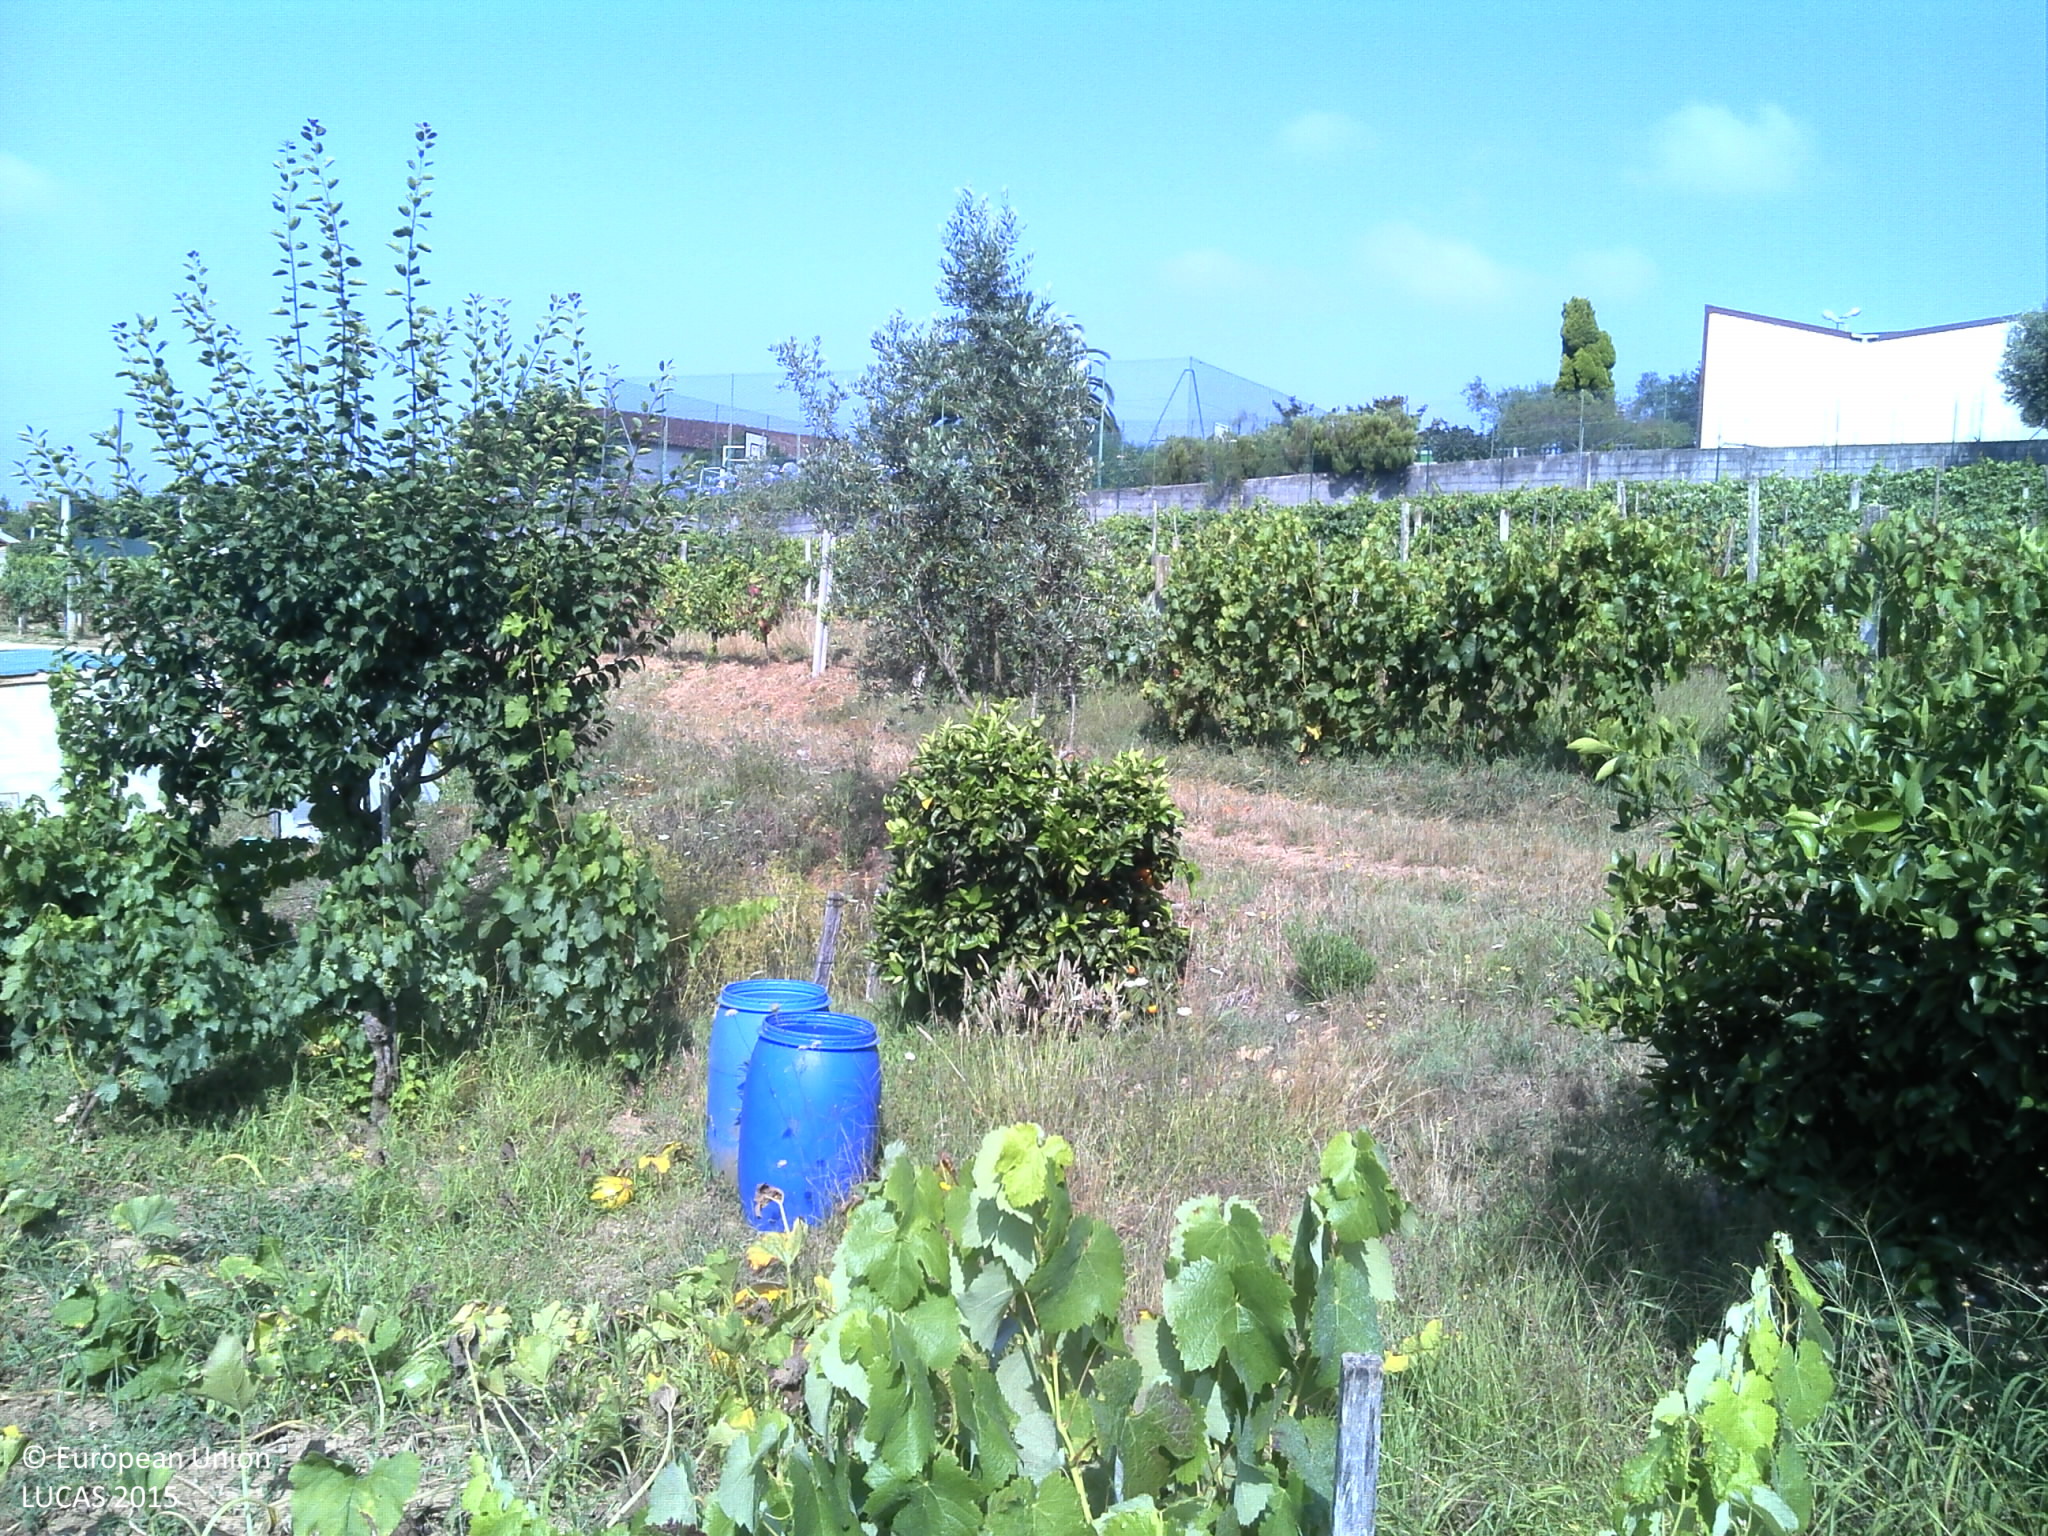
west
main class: Cropland
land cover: Vineyards
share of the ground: 25 - 50 %
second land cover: Grassland without tree/shrub cover
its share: > 75 %
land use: Agriculture (excluding fallow land and kitchen gardens)
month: July
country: PT
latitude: 40.6315
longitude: -8.4282
